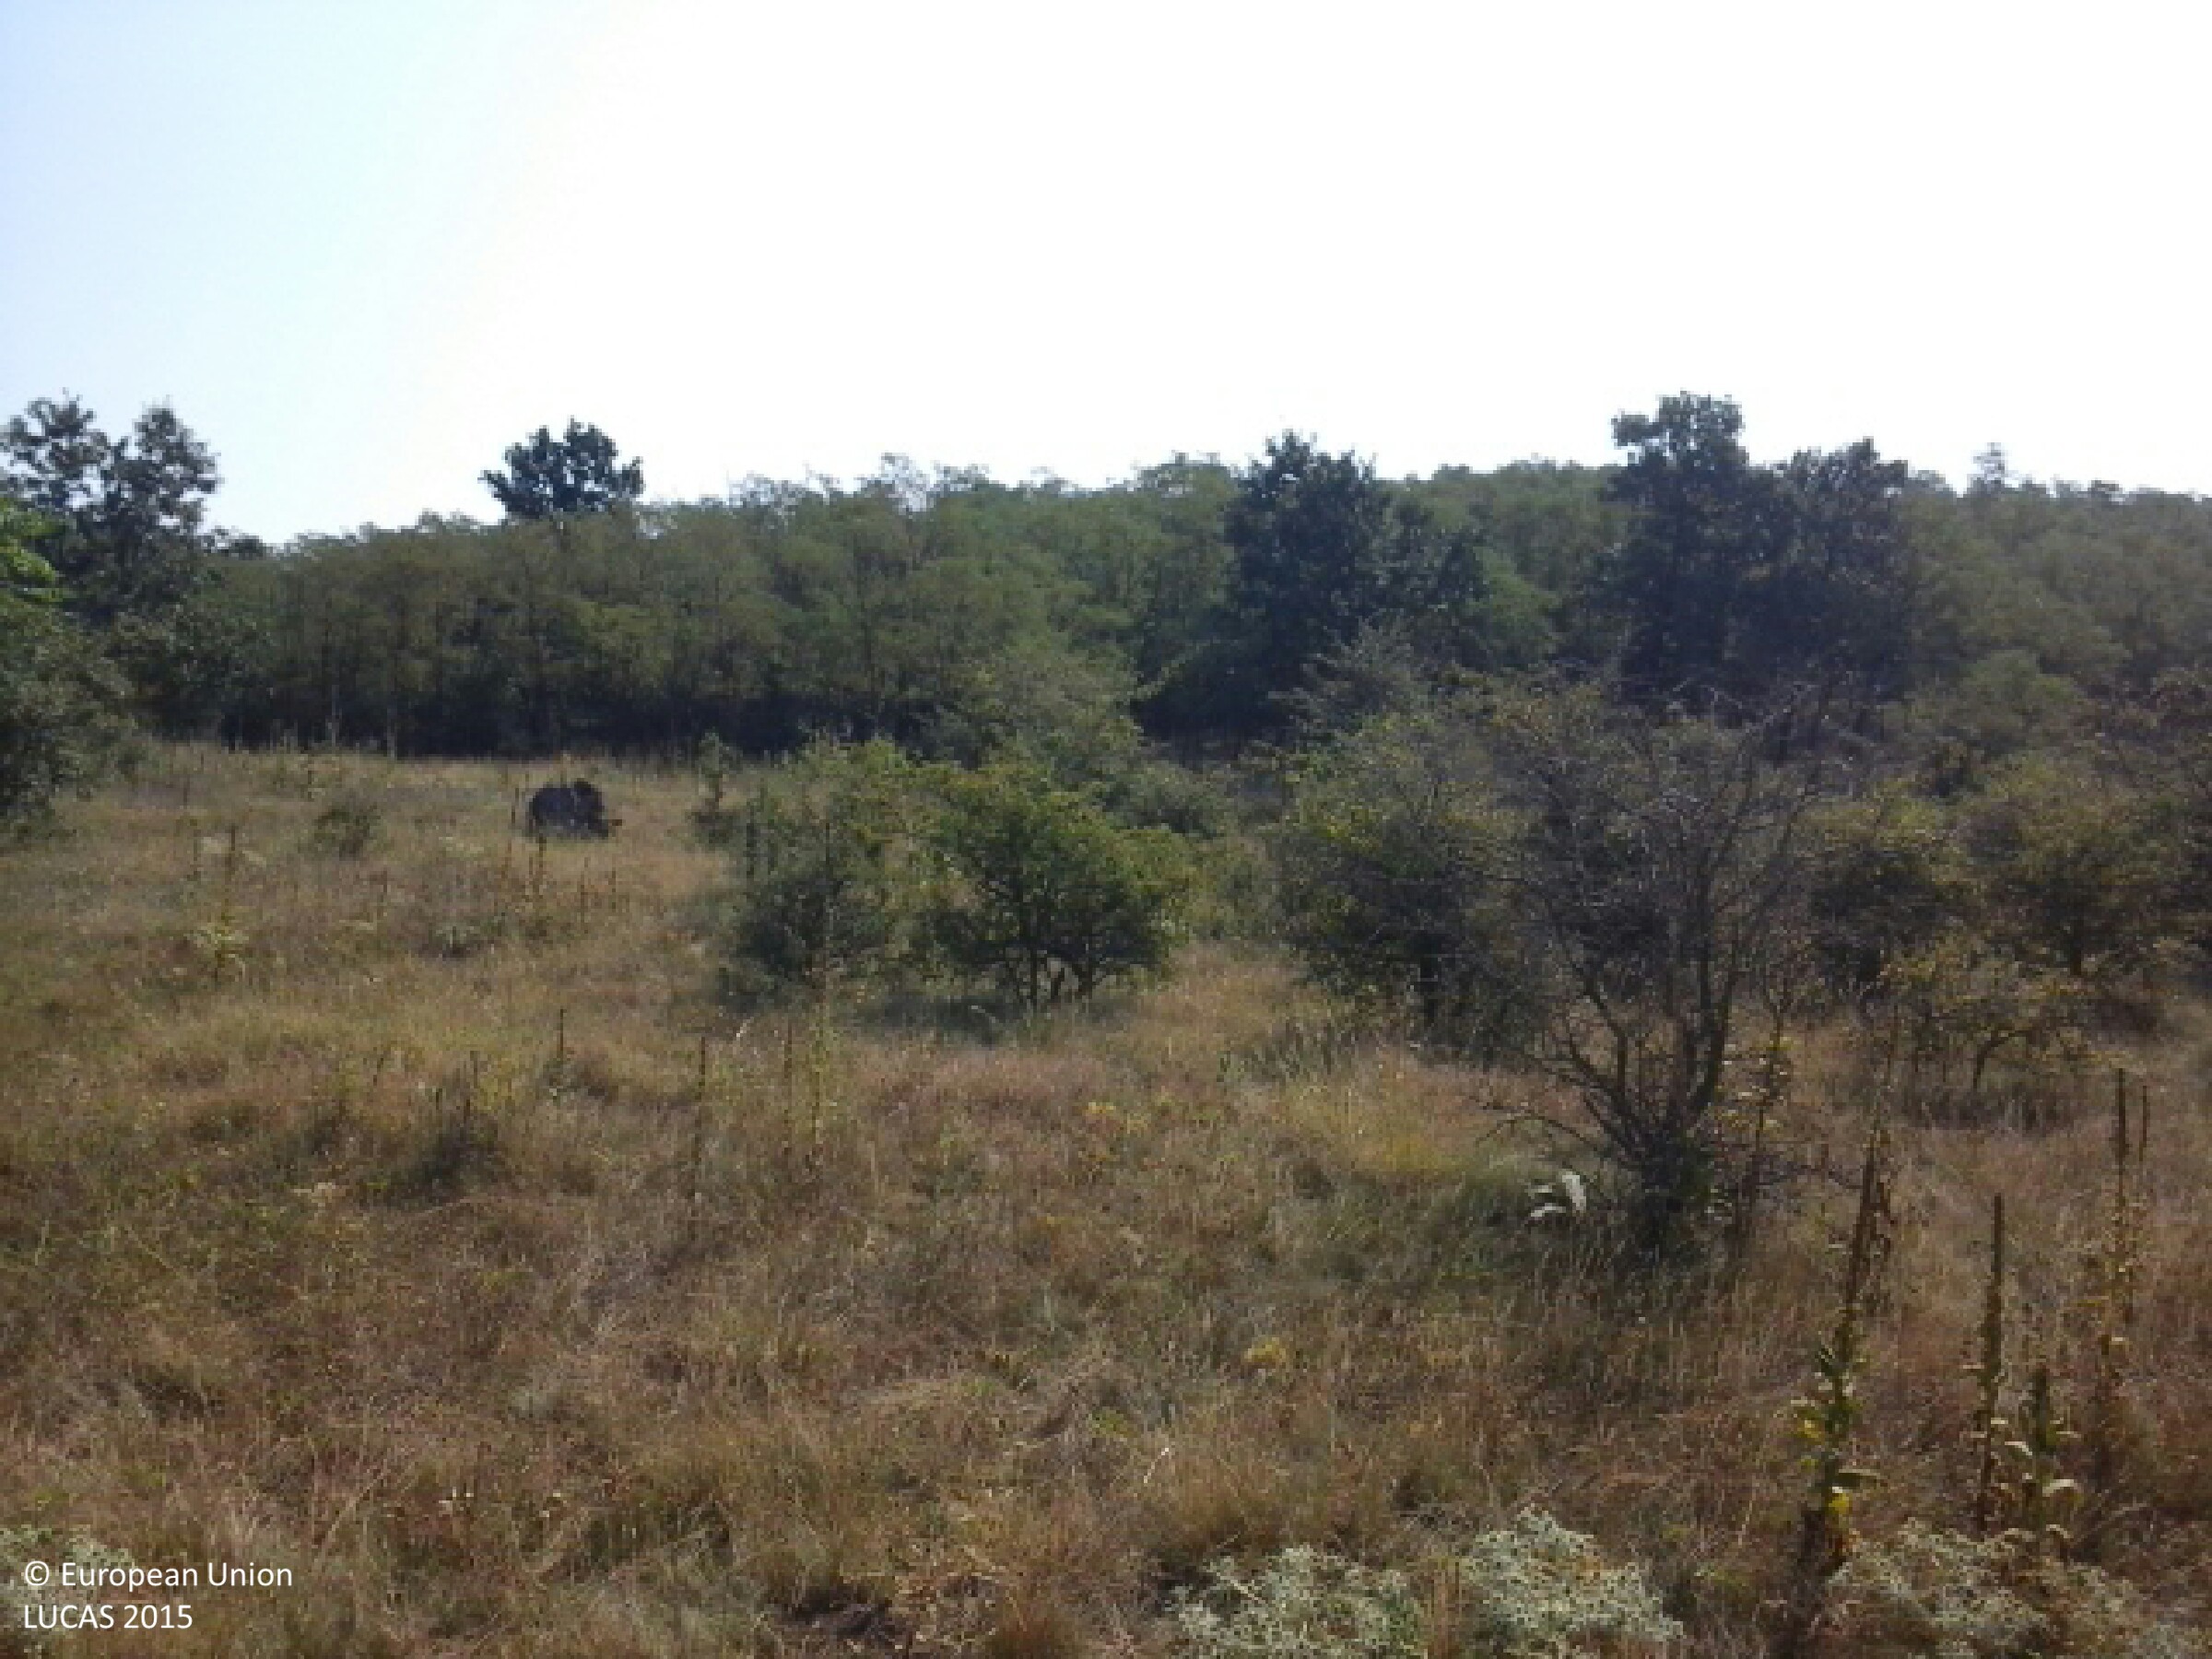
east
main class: Grassland
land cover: Grassland with sparse tree/shrub cover
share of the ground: > 75 %
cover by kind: herbaceous plants 90 %, broadleaved forest trees 5 %, shrubs 5 %
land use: Semi-natural and natural areas not in use
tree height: < 5 m
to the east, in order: Grassland with sparse tree/shrub cover; Tracks; Grass margins; Broadleaved woodland
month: August
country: HU
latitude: 47.2249
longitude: 18.5048
